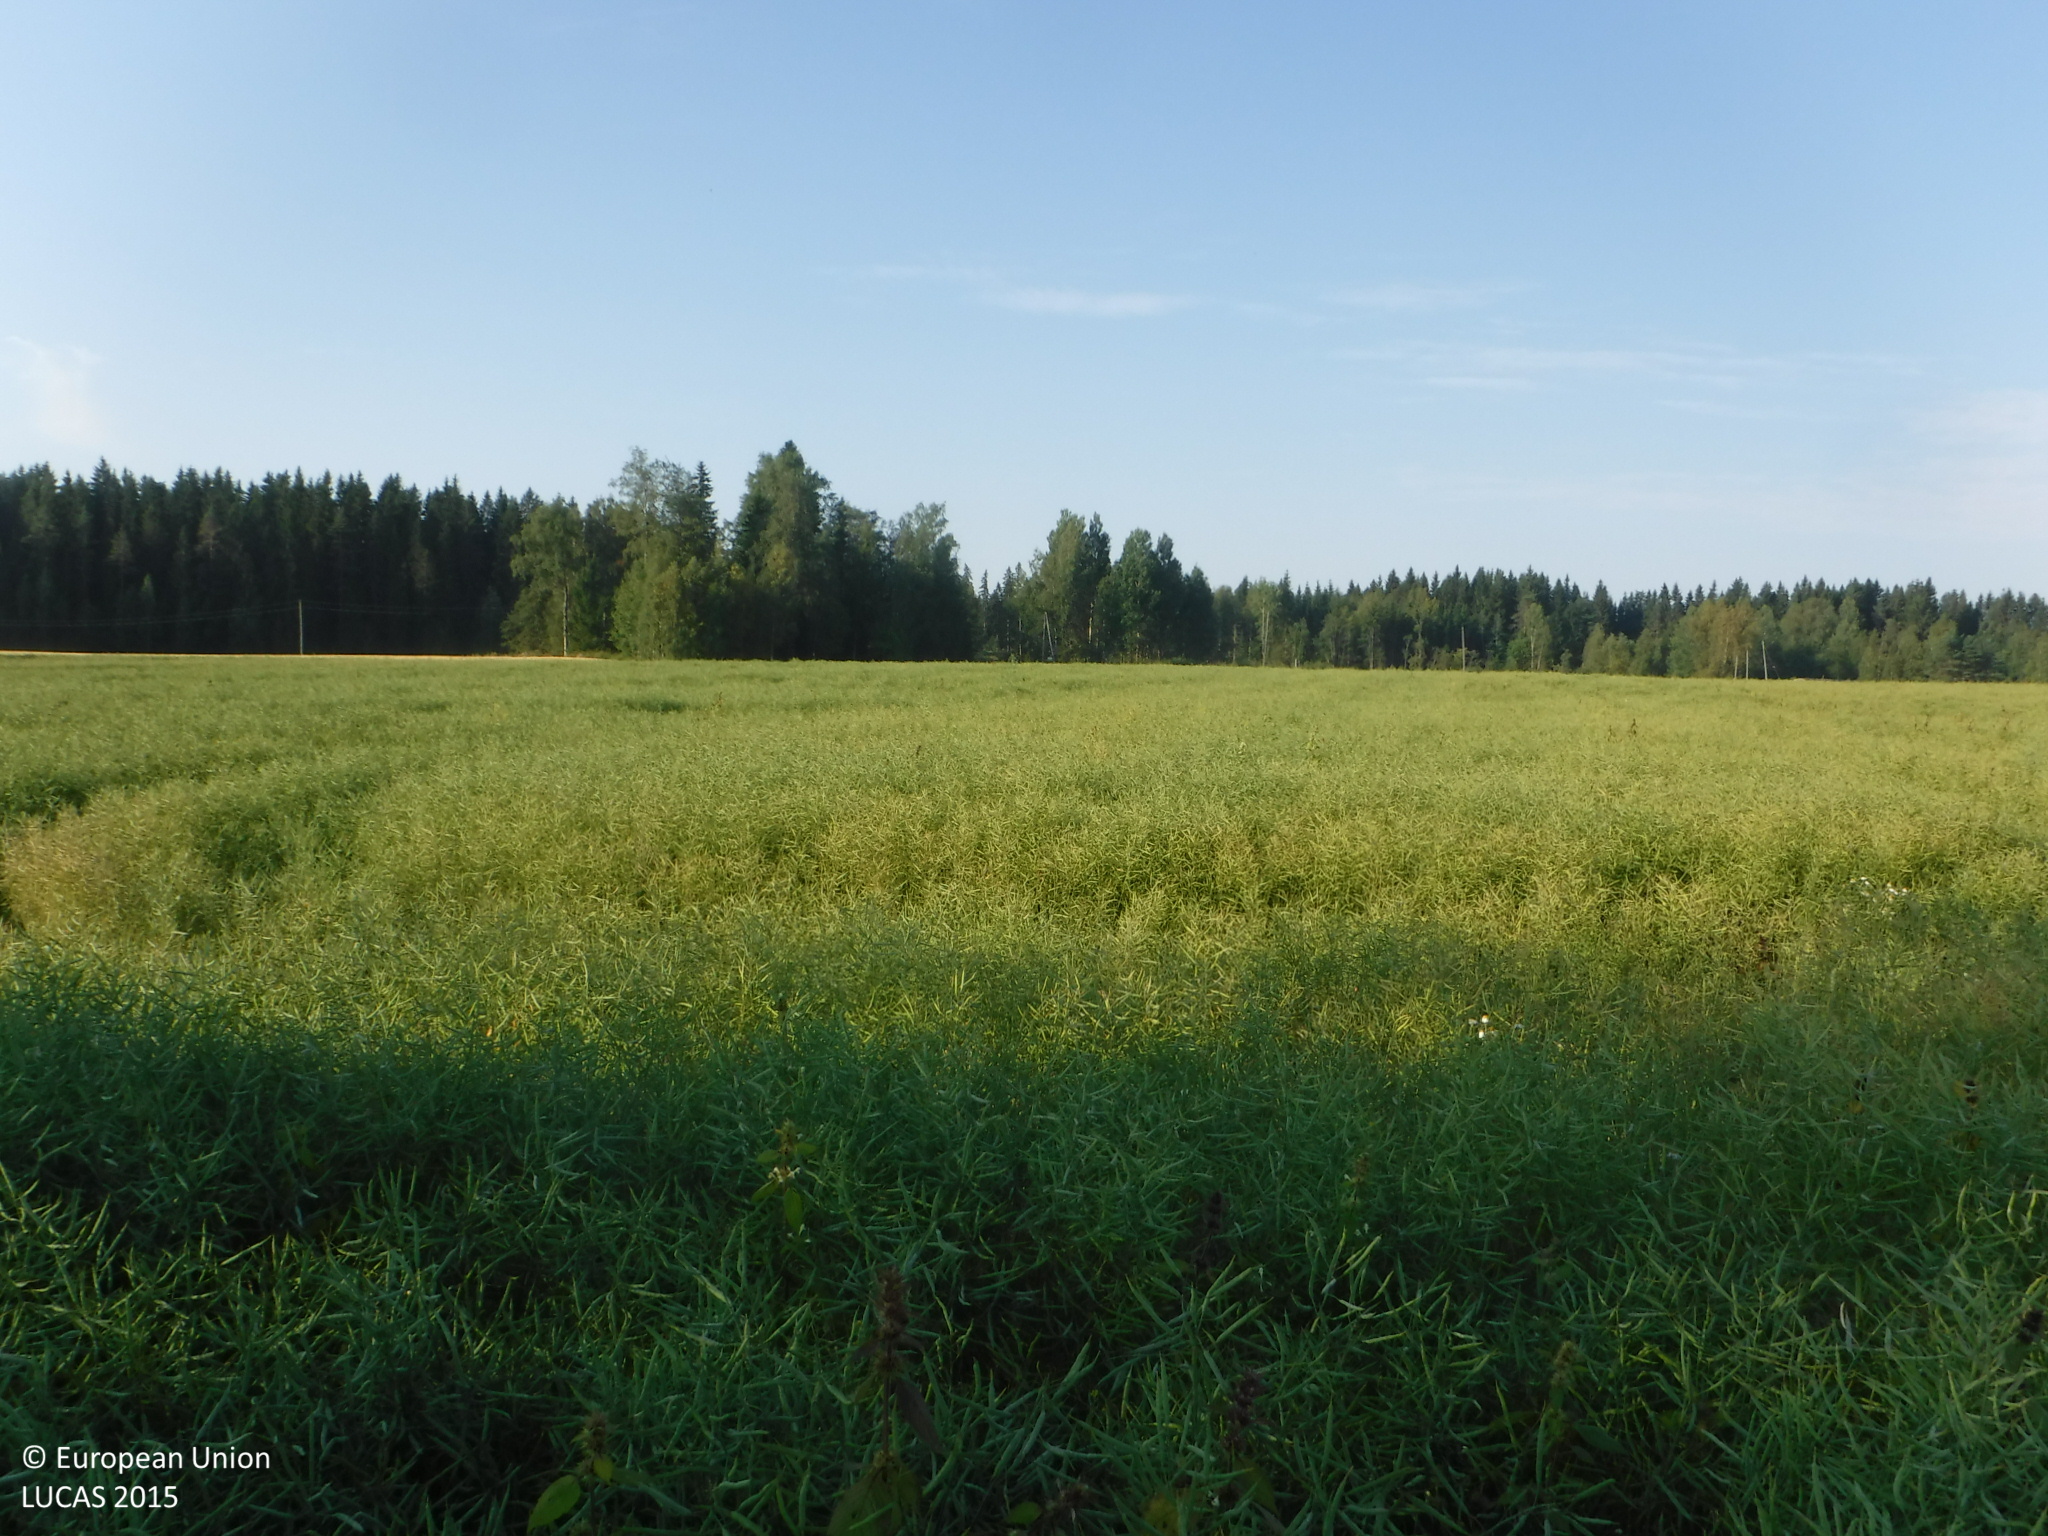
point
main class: Cropland
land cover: Rape and turnip rape
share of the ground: > 75 %
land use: Agriculture (excluding fallow land and kitchen gardens)
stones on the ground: < 10 %
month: August
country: FI
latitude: 61.1014
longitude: 23.1165
